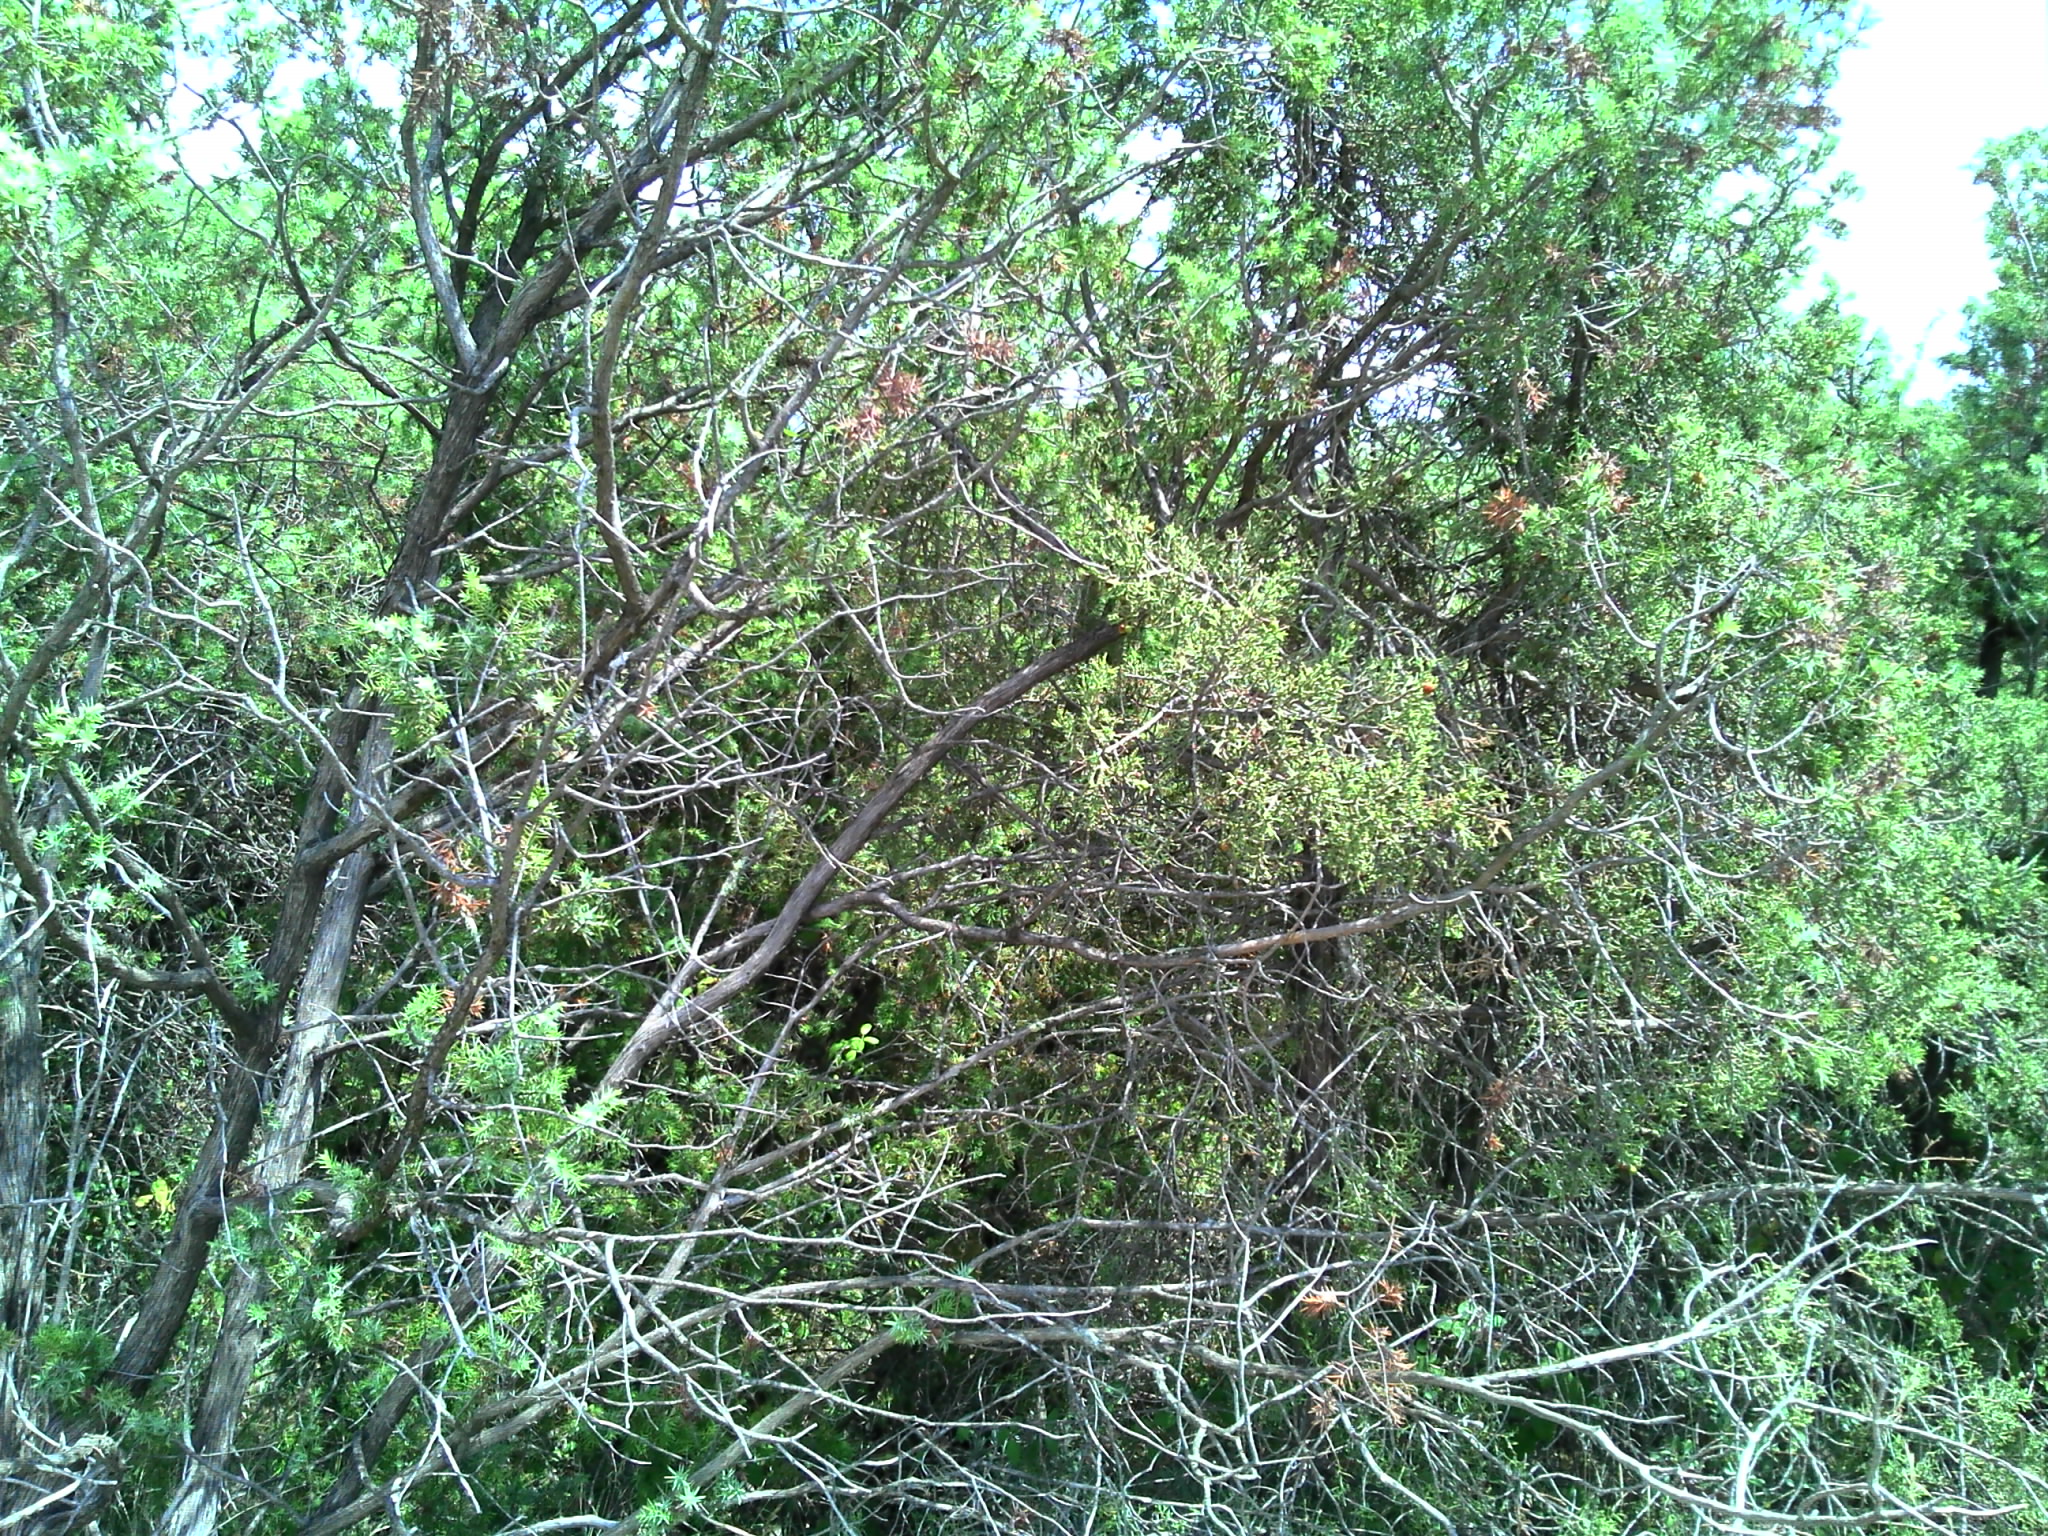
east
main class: Shrubland
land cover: Shrubland with sparse tree cover
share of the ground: > 75 %
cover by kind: shrubs 45 %, herbaceous plants 30 %, consolidated bare surface 20 %, coniferous forest trees 5 %
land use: Semi-natural and natural areas not in use
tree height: < 5 m
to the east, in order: Shrubland with sparse tree cover; Shrubland without tree cover; Shrubland with sparse tree cover
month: July
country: FR
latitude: 44.1241
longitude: 4.3467
